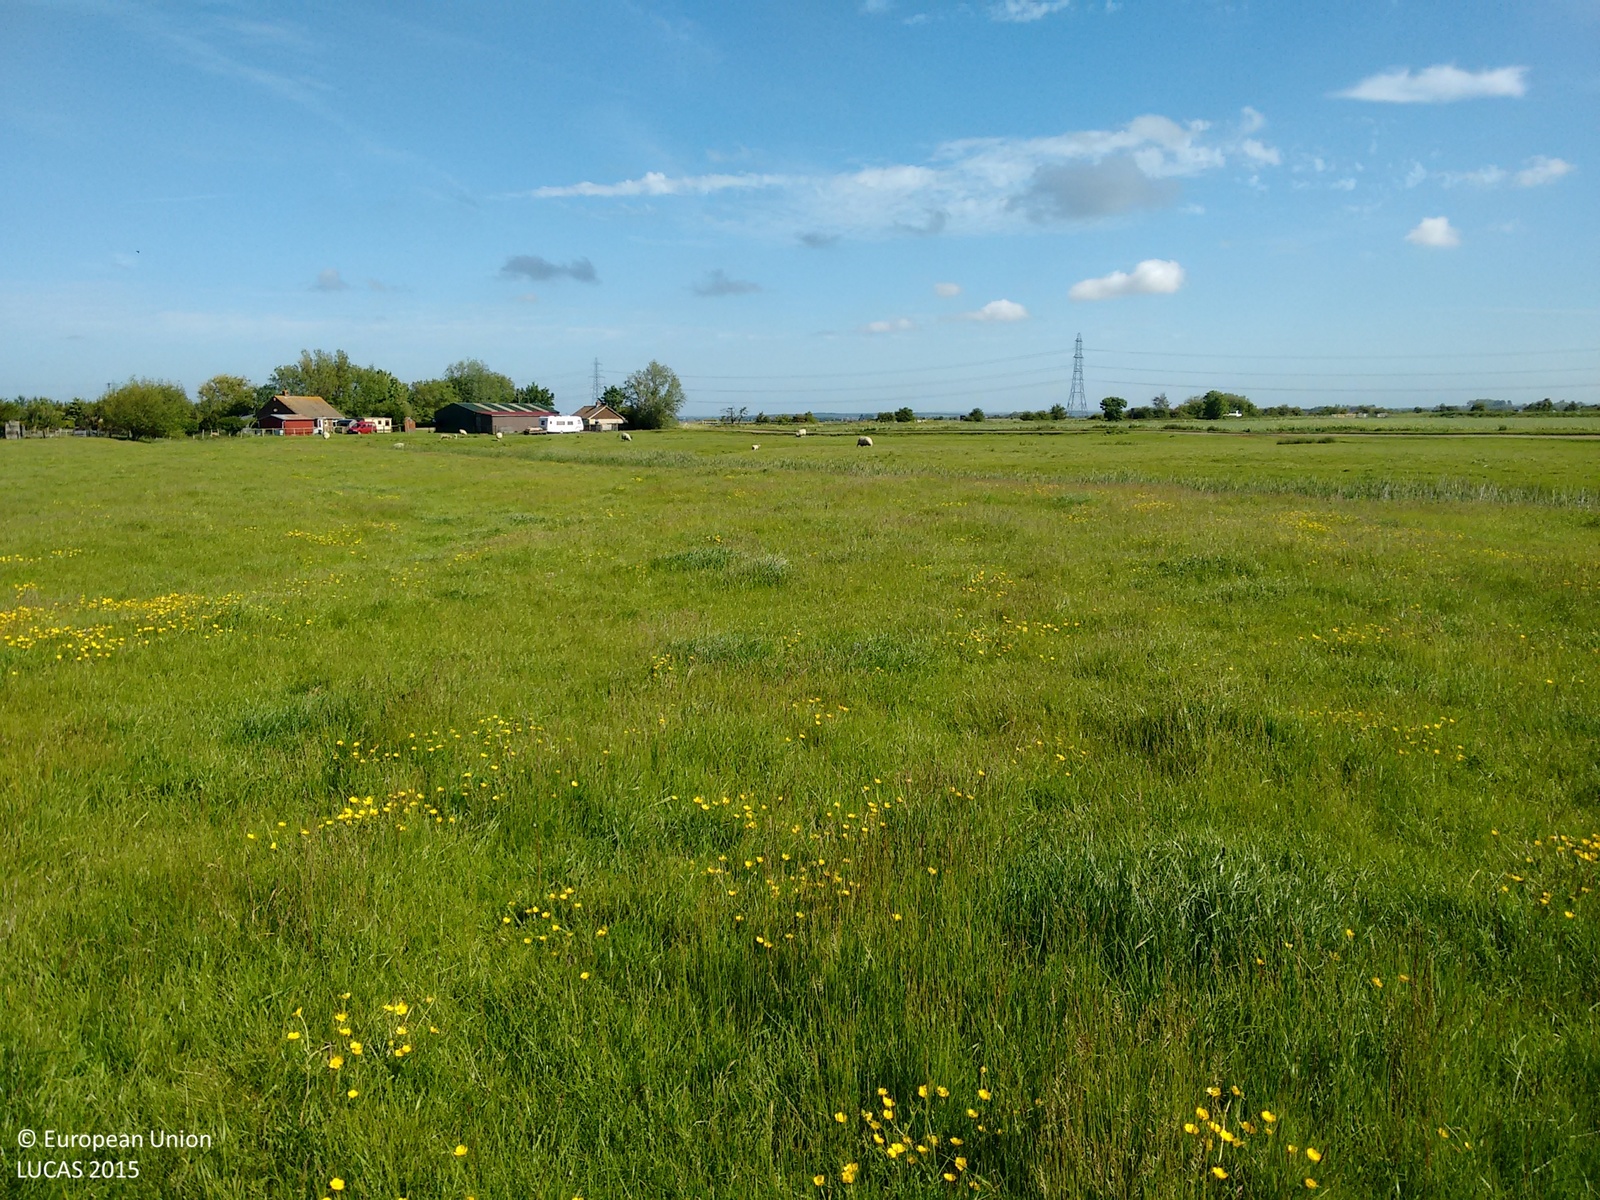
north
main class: Grassland
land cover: Grassland without tree/shrub cover
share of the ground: > 75 %
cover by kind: herbaceous plants 100 %
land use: Agriculture (excluding fallow land and kitchen gardens)
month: June
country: GB
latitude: 50.9691
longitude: 0.7899
